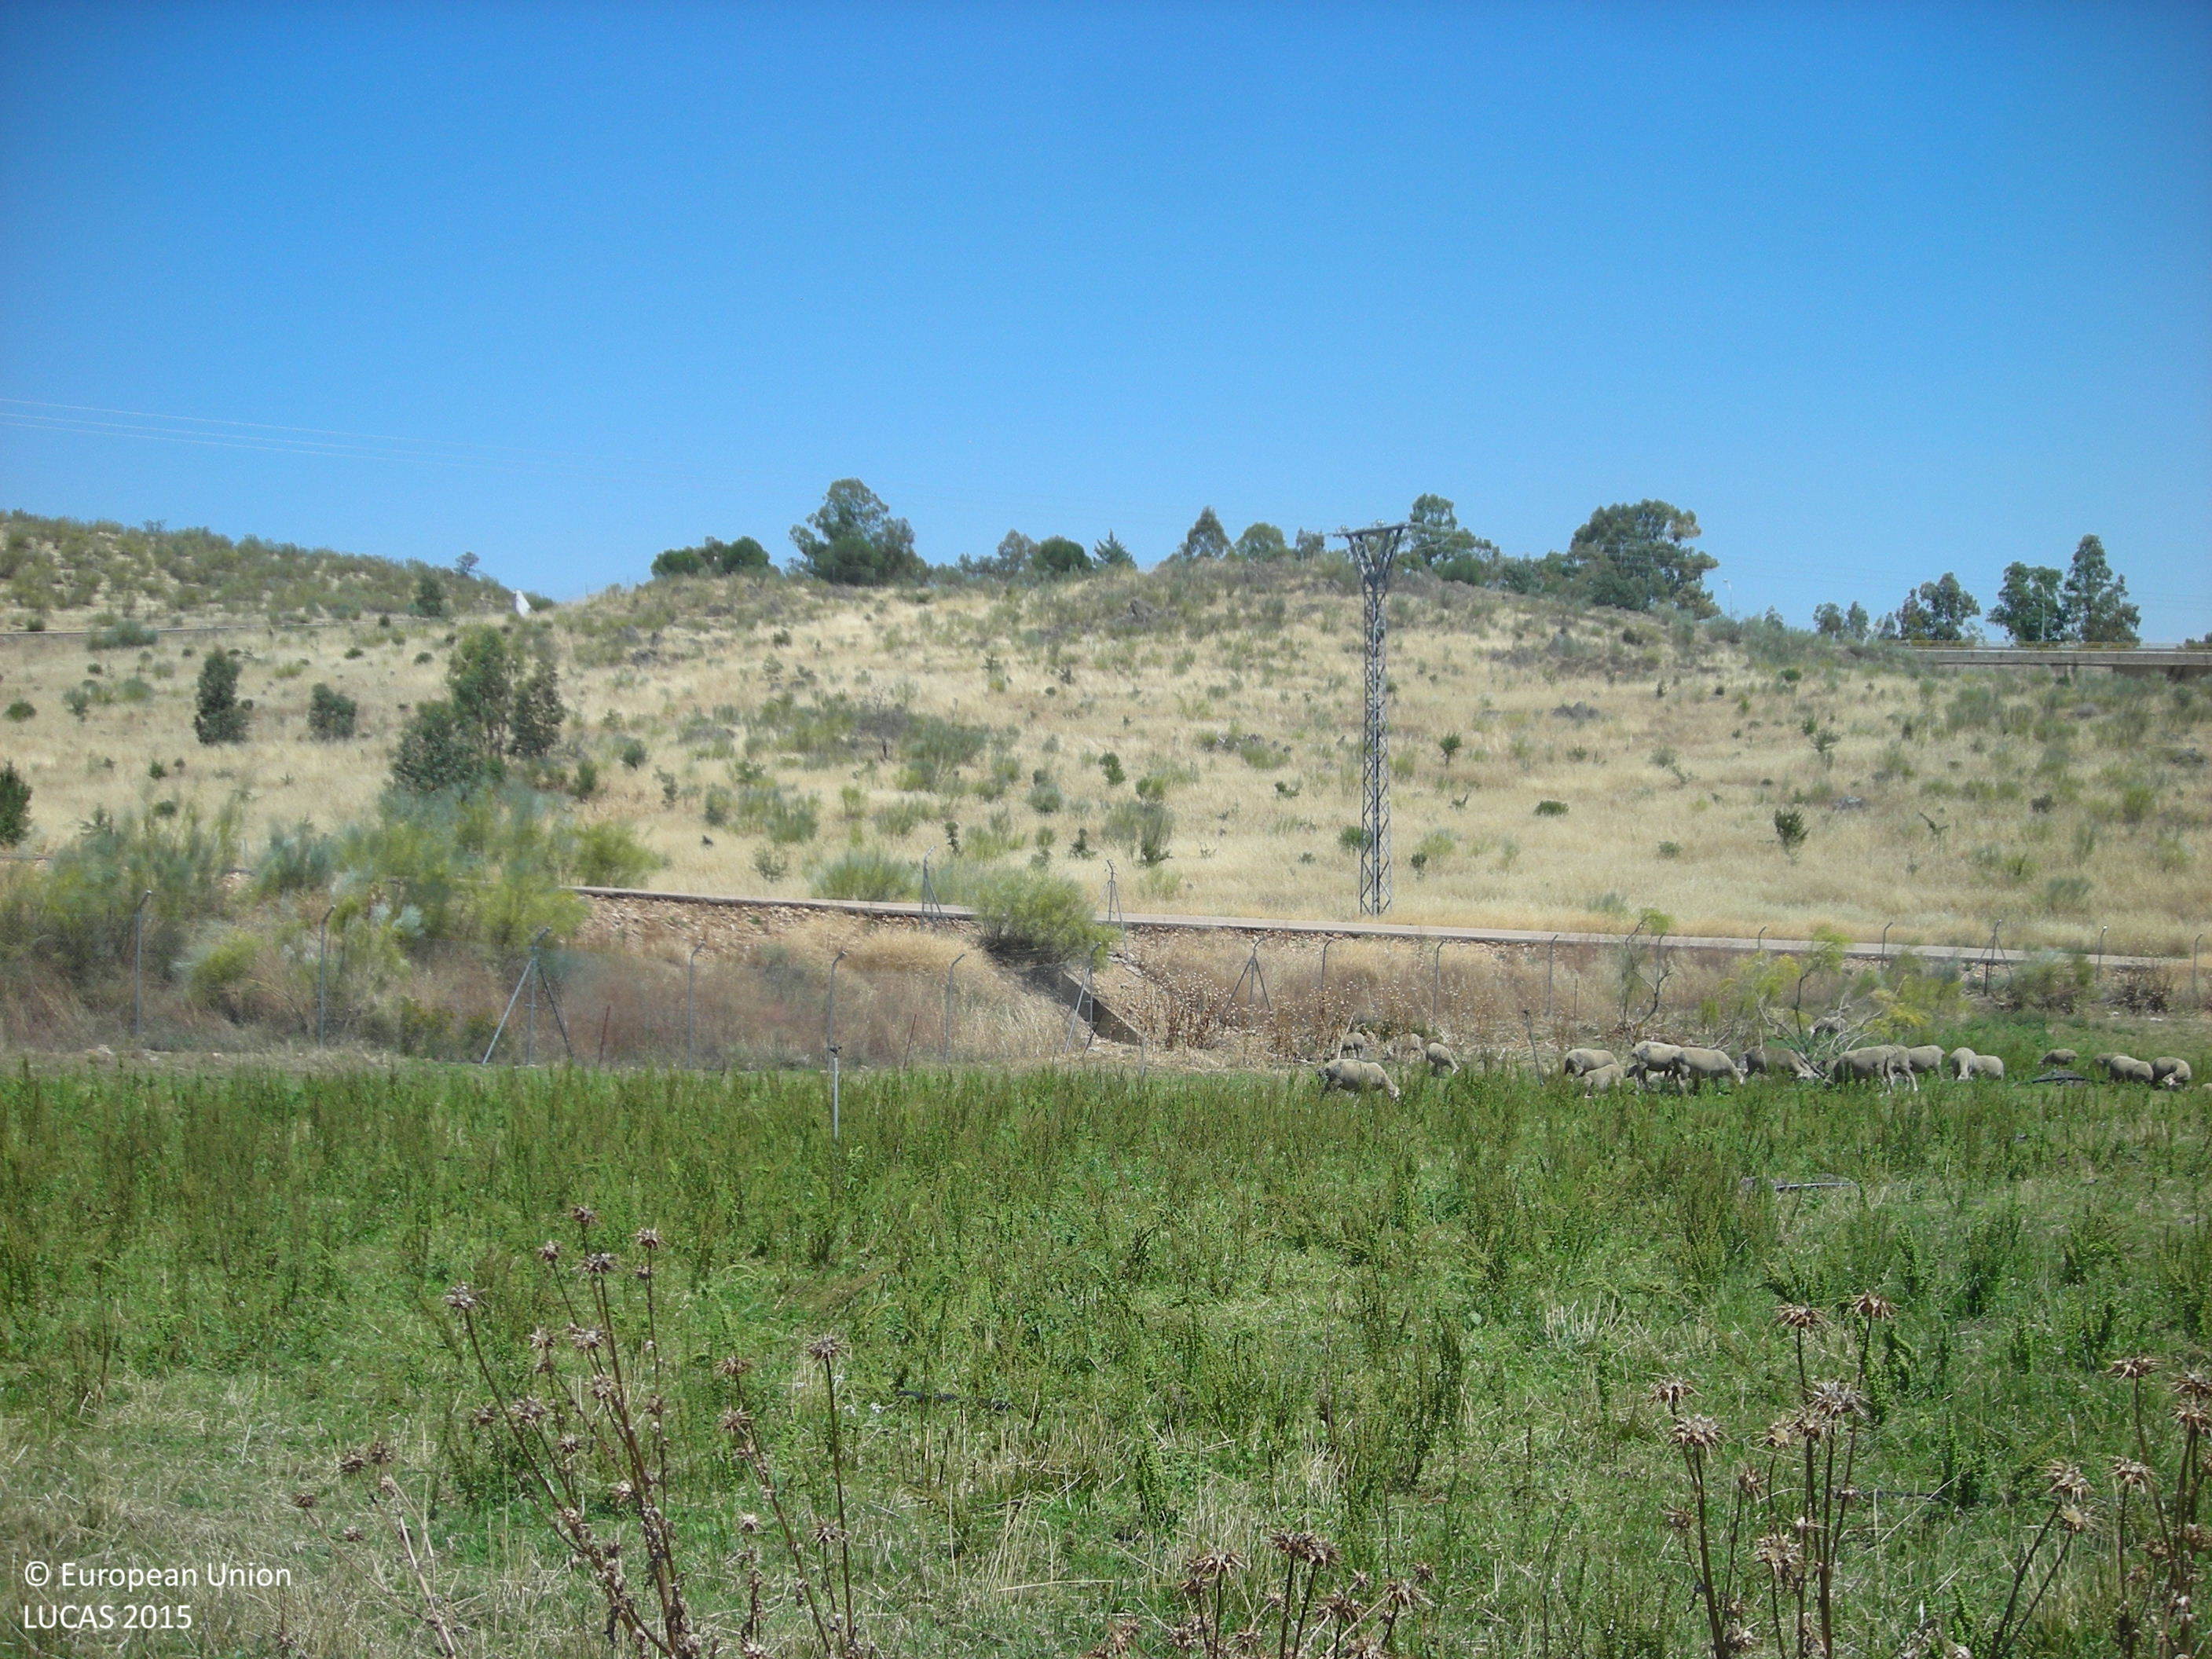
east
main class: Cropland
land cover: Mixed cereals for fodder
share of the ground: > 75 %
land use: Agriculture (excluding fallow land and kitchen gardens)
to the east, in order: Mixed cereals for fodder; Fences; Artificial constructions in urban areas; Fences; Mixed cereals for fodder
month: June
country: ES
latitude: 38.9191
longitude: -5.4856
